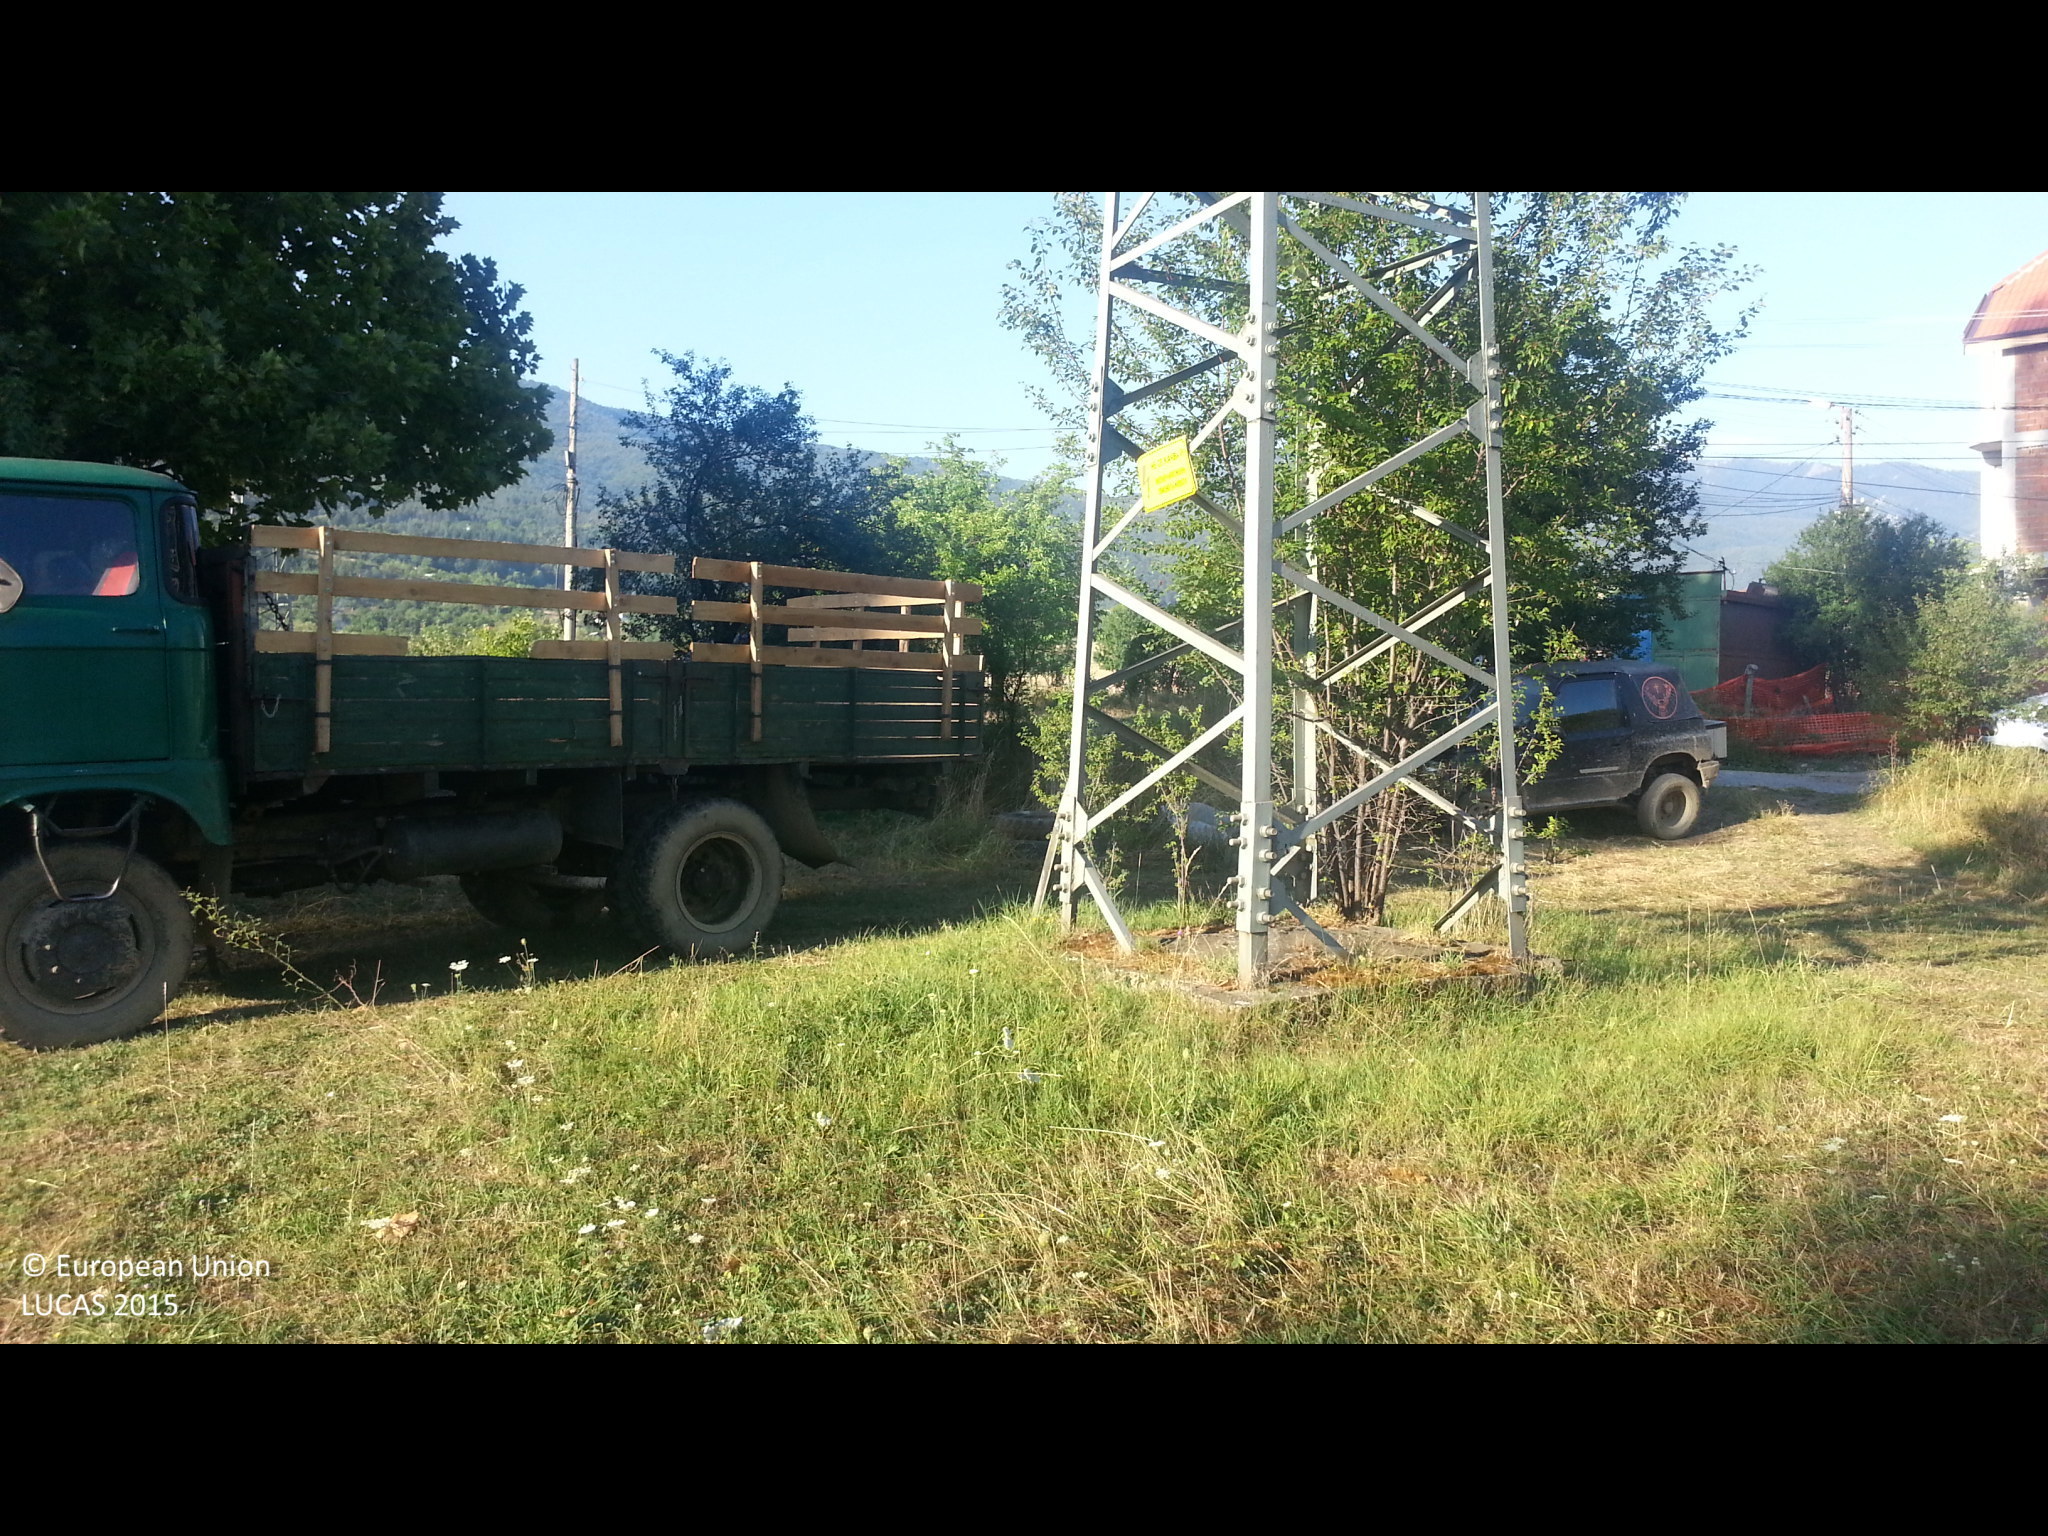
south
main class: Grassland
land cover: Grassland without tree/shrub cover
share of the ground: > 75 %
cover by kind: herbaceous plants 100 %
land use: Abandoned areas
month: August
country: BG
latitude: 42.2751
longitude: 22.6679
